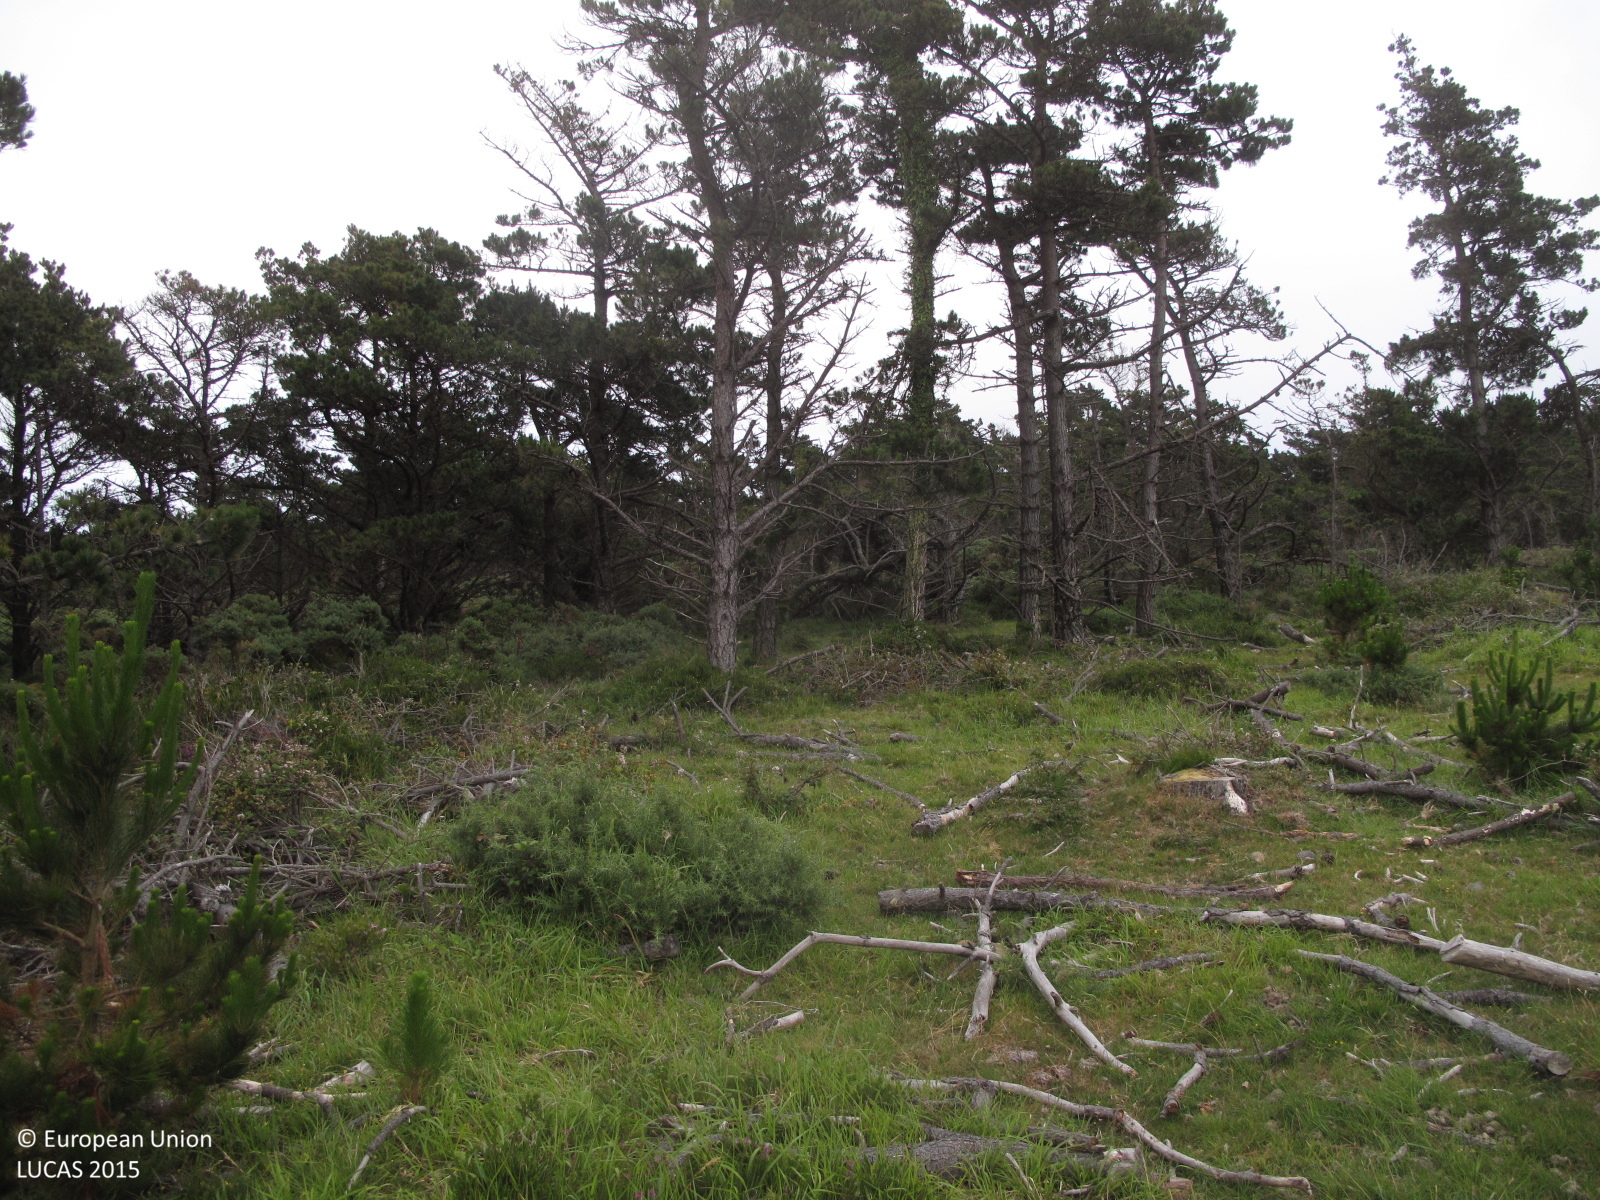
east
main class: Woodland
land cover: Pine dominated coniferous woodland
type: exotic forest
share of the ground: 25 - 50 %
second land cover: Shrubland without tree cover
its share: 10 - 25 %
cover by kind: coniferous forest trees 40 %, herbaceous plants 40 %, shrubs 20 %
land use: Forestry
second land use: Agriculture (excluding fallow land and kitchen gardens)
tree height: > 5 m
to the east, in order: Pine dominated coniferous woodland; Shrubland without tree cover; Shrubland with sparse tree cover; Shrubland without tree cover
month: July
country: ES
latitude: 43.7569
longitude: -7.8942
